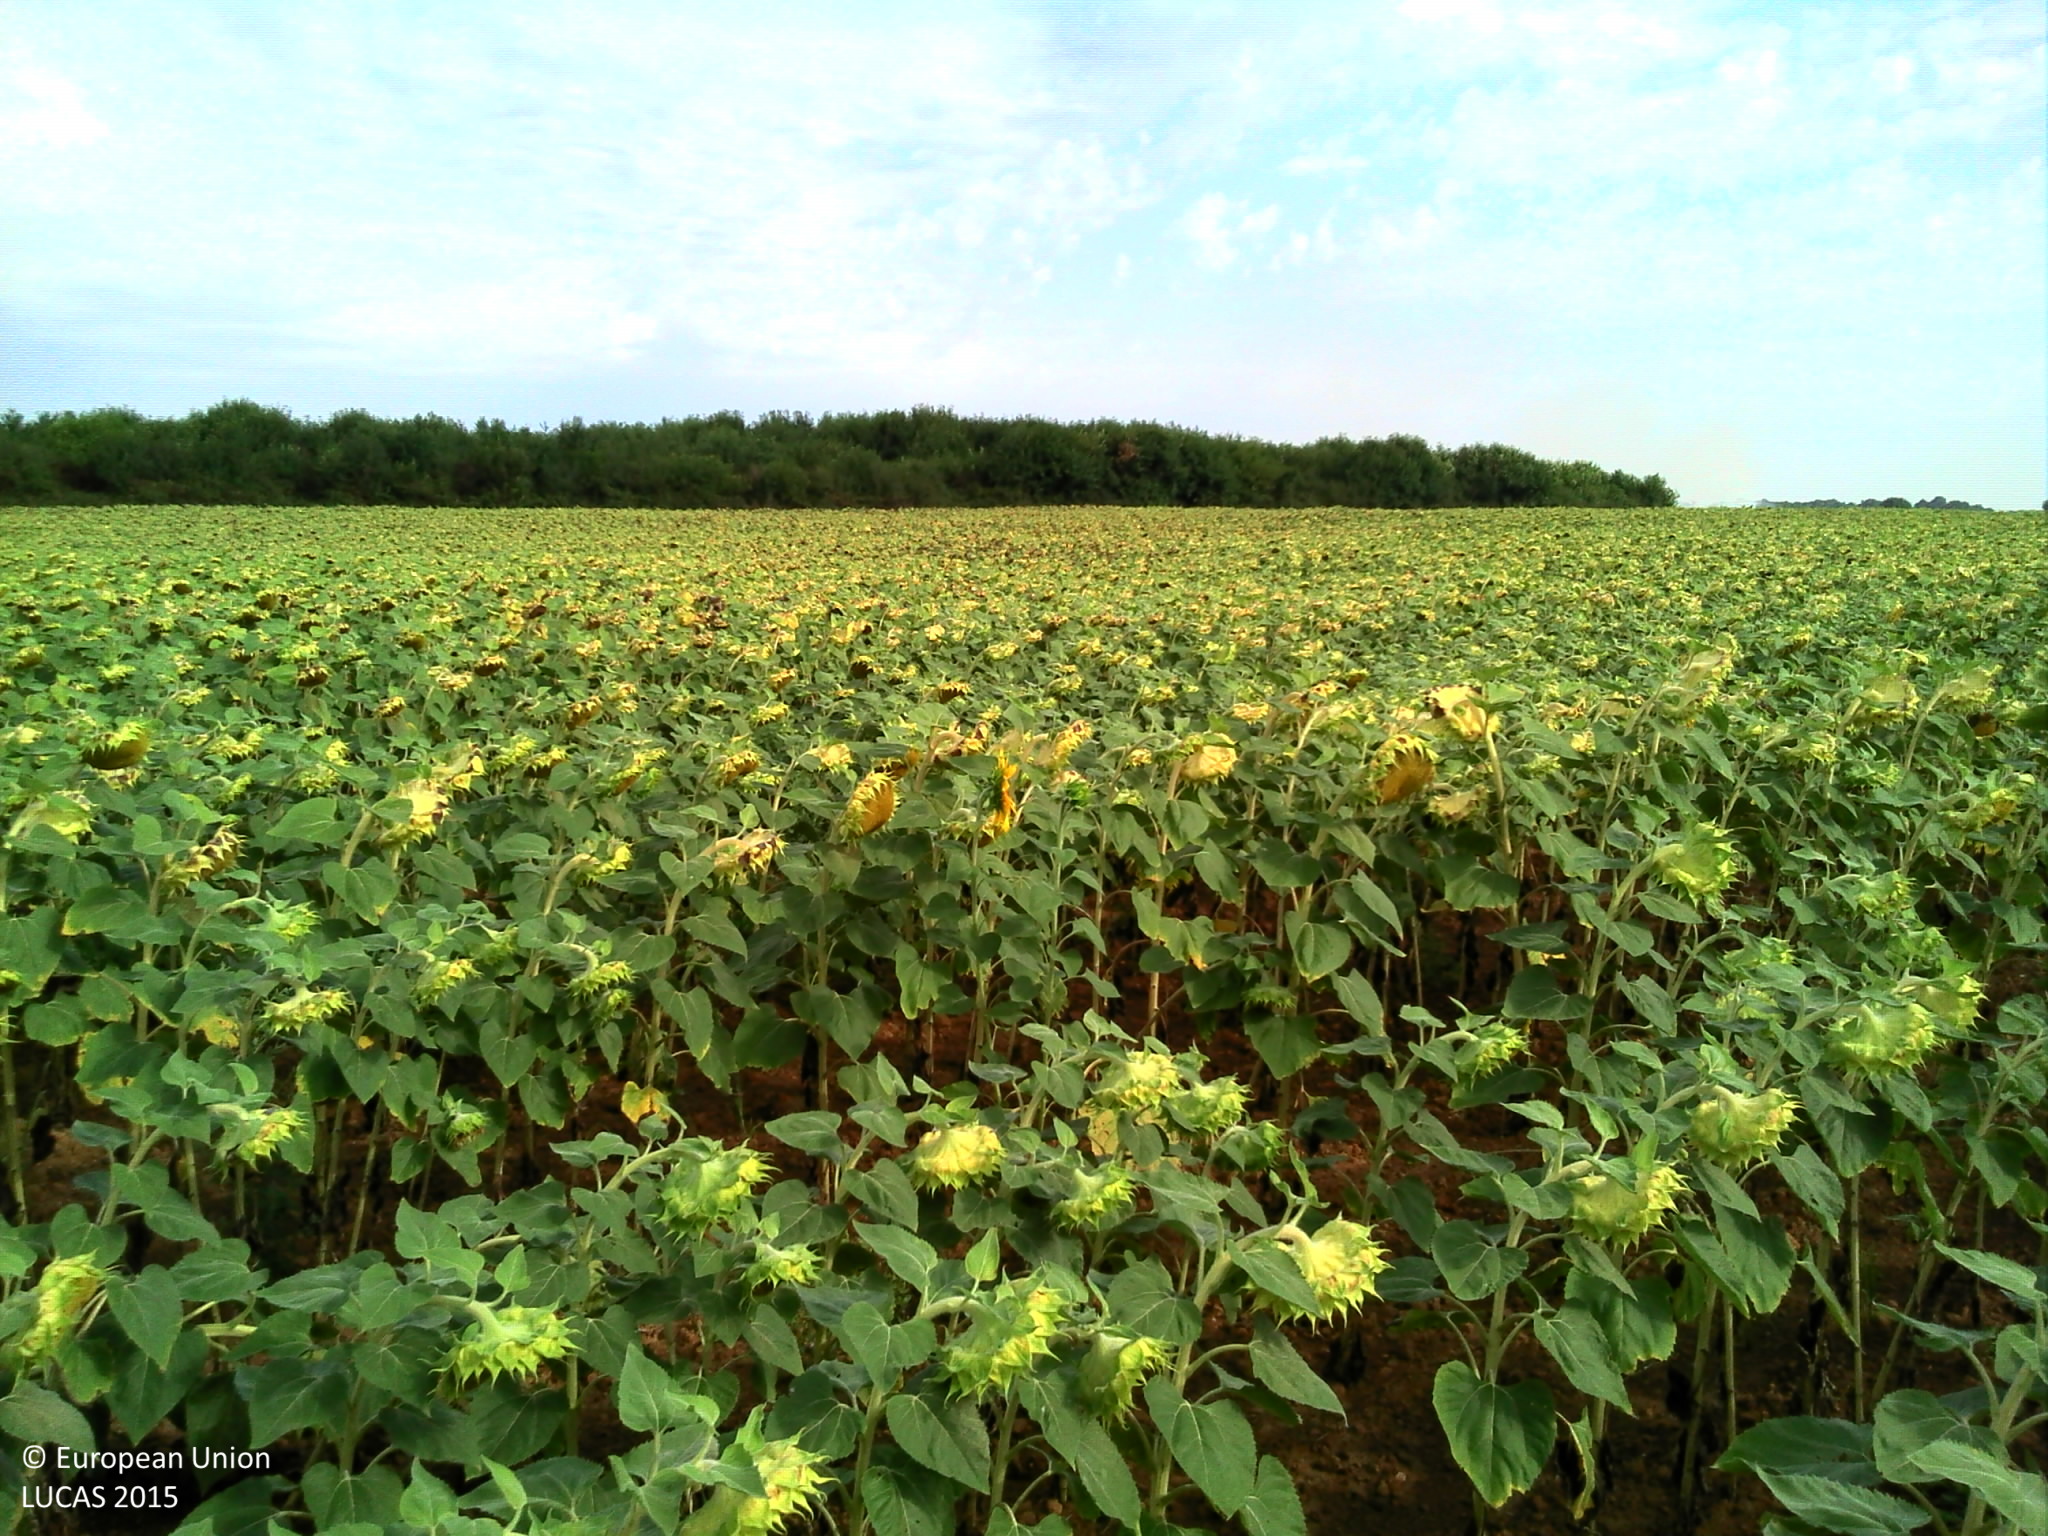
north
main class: Cropland
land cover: Sunflower
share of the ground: > 75 %
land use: Agriculture (excluding fallow land and kitchen gardens)
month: August
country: FR
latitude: 46.1865
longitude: 0.3564
